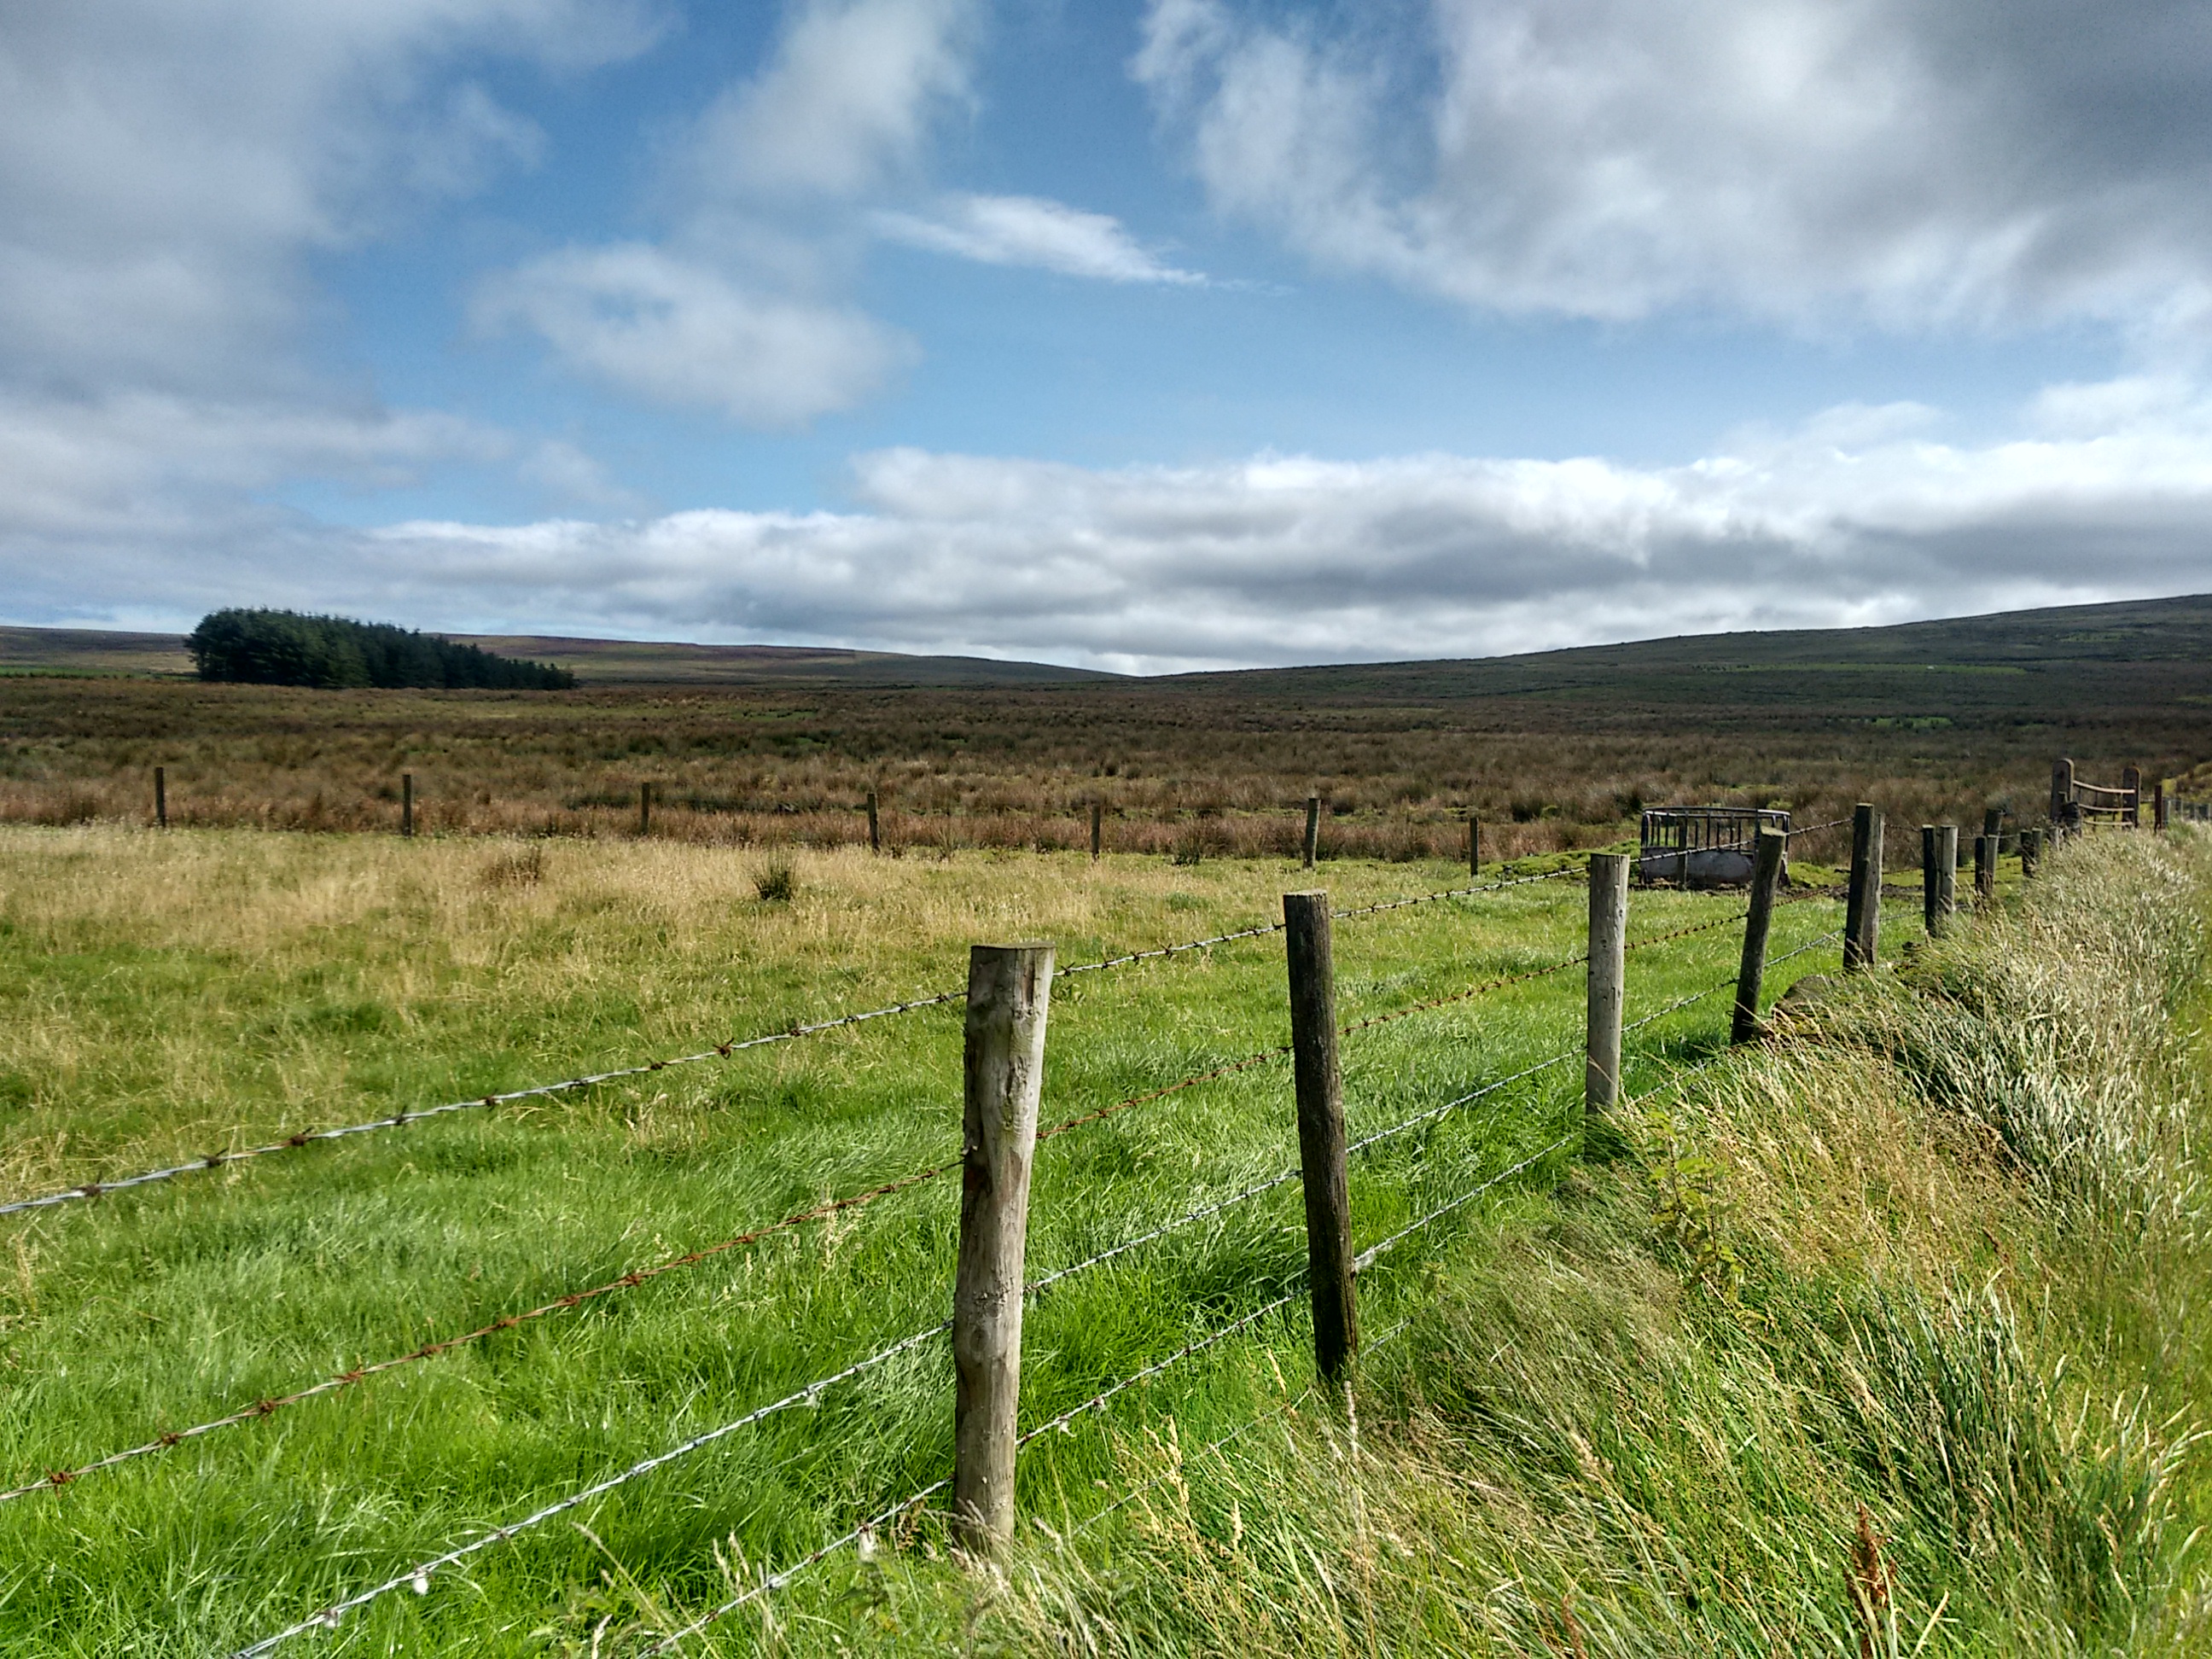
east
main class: Grassland
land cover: Grassland without tree/shrub cover
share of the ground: > 75 %
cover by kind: herbaceous plants 100 %
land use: Agriculture (excluding fallow land and kitchen gardens)
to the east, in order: Grassland without tree/shrub cover; Fences; Grassland without tree/shrub cover; Rivers and streams; Grassland without tree/shrub cover; Tracks; Grassland without tree/shrub cover
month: September
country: GB
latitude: 54.8732
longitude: -6.0524
